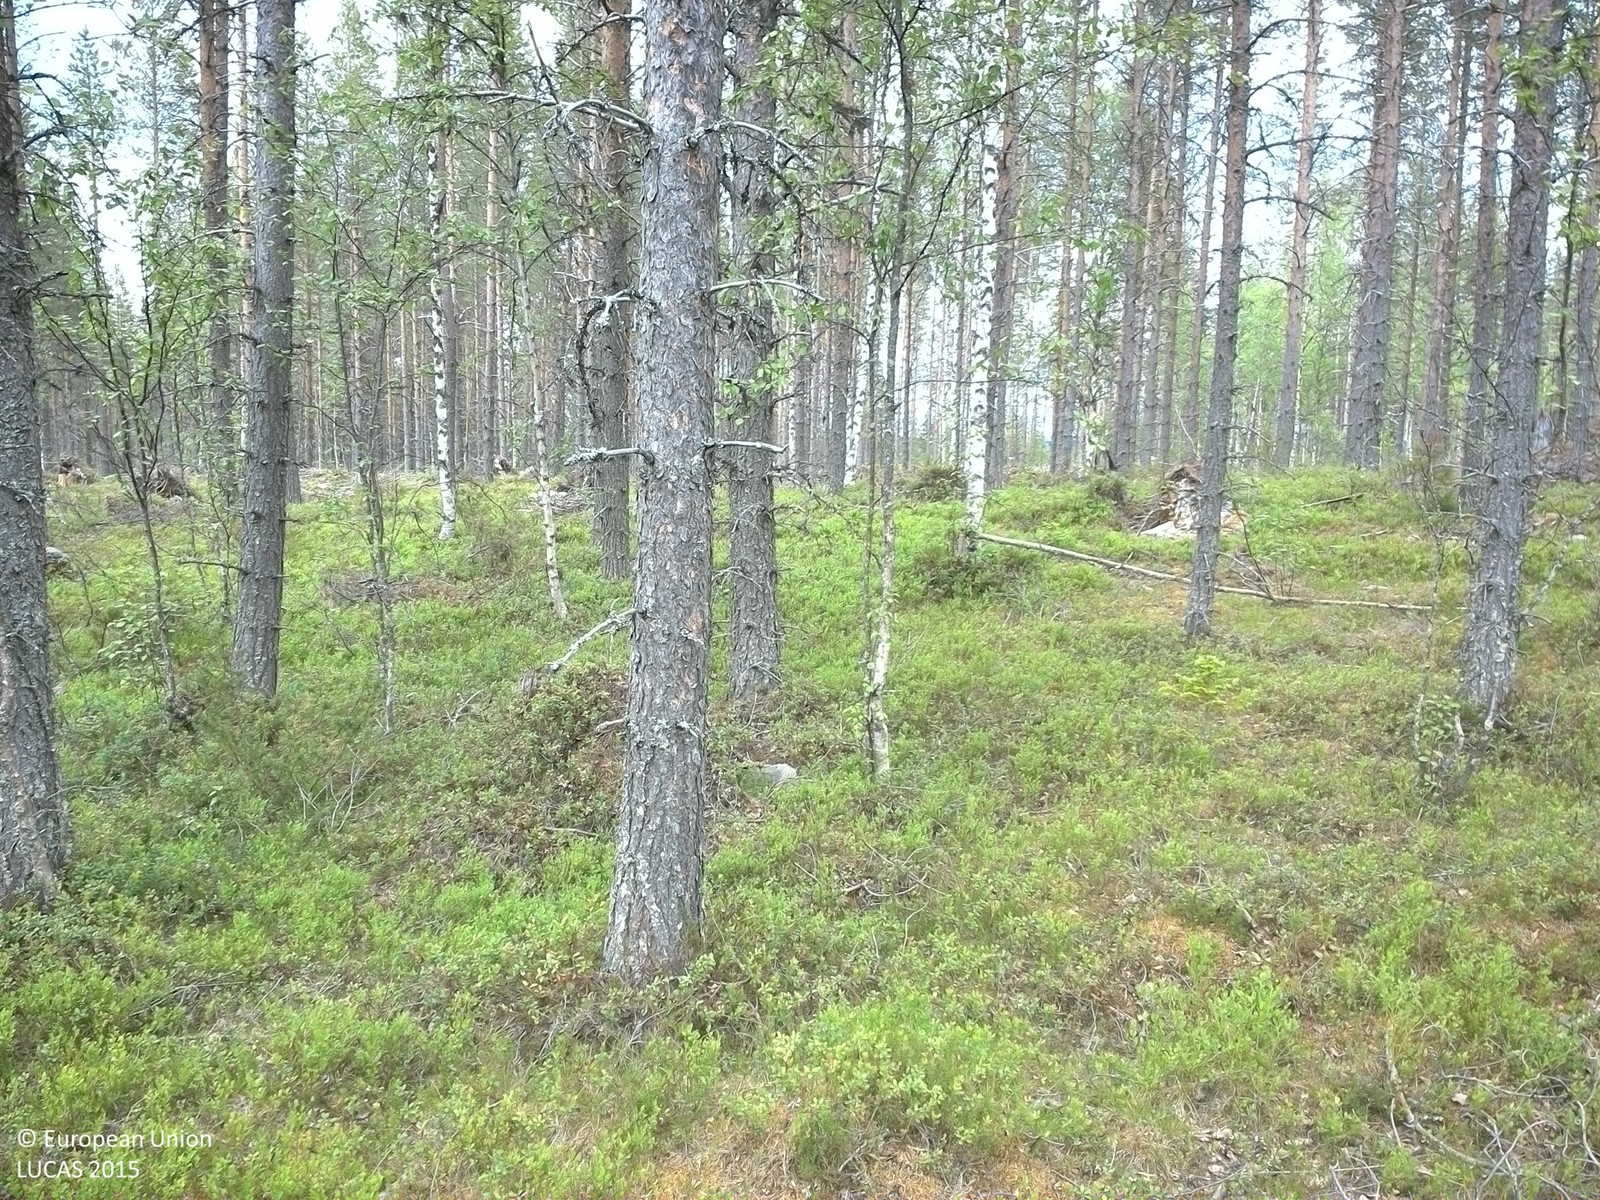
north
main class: Woodland
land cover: Pine dominated mixed woodland
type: boreal forest
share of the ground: 25 - 50 %
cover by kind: coniferous forest trees 35 %, shrubs 30 %, broadleaved forest trees 15 %, lichens and mosses 10 %, herbaceous plants 5 %, unconsolidated bare surface 5 %
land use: Forestry
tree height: > 5 m
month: July
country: SE
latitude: 64.1986
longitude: 16.7854
